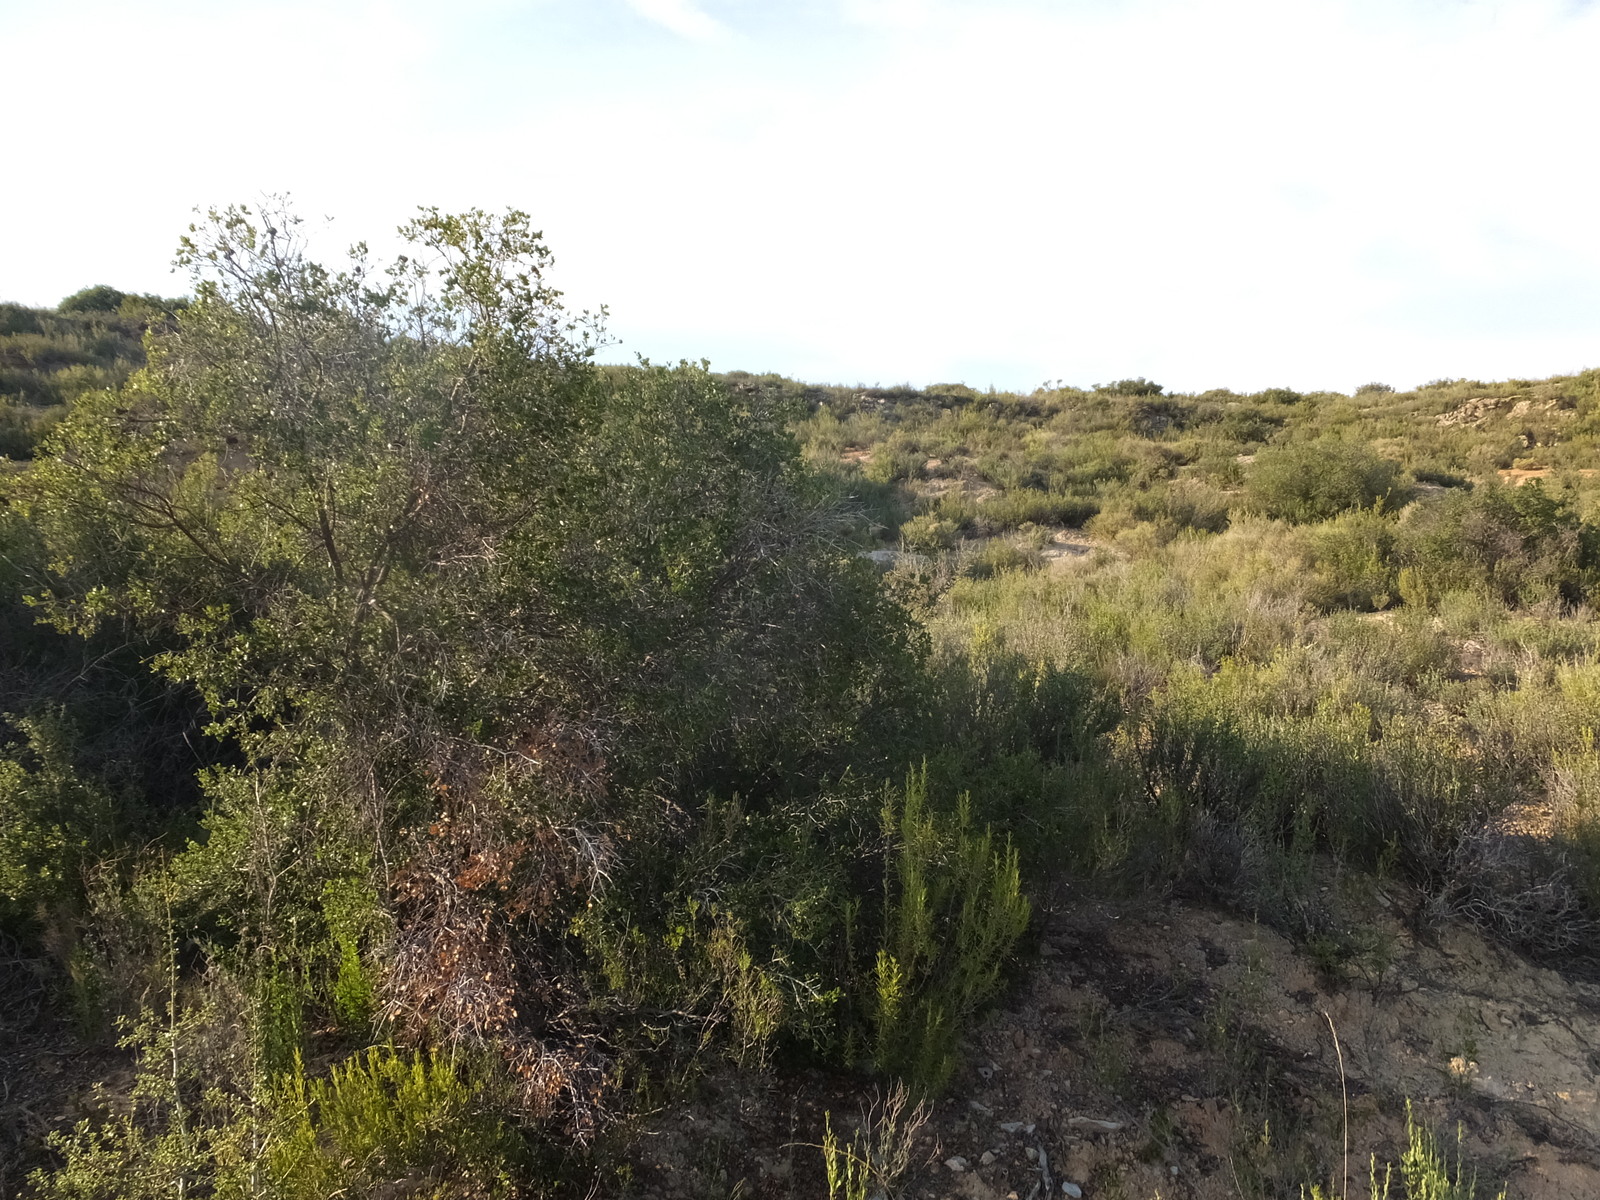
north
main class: Shrubland
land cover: Shrubland without tree cover
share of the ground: > 75 %
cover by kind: consolidated bare surface 60 %, shrubs 20 %, herbaceous plants 20 %
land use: Semi-natural and natural areas not in use
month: July
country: ES
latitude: 41.1550
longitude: 0.1582
